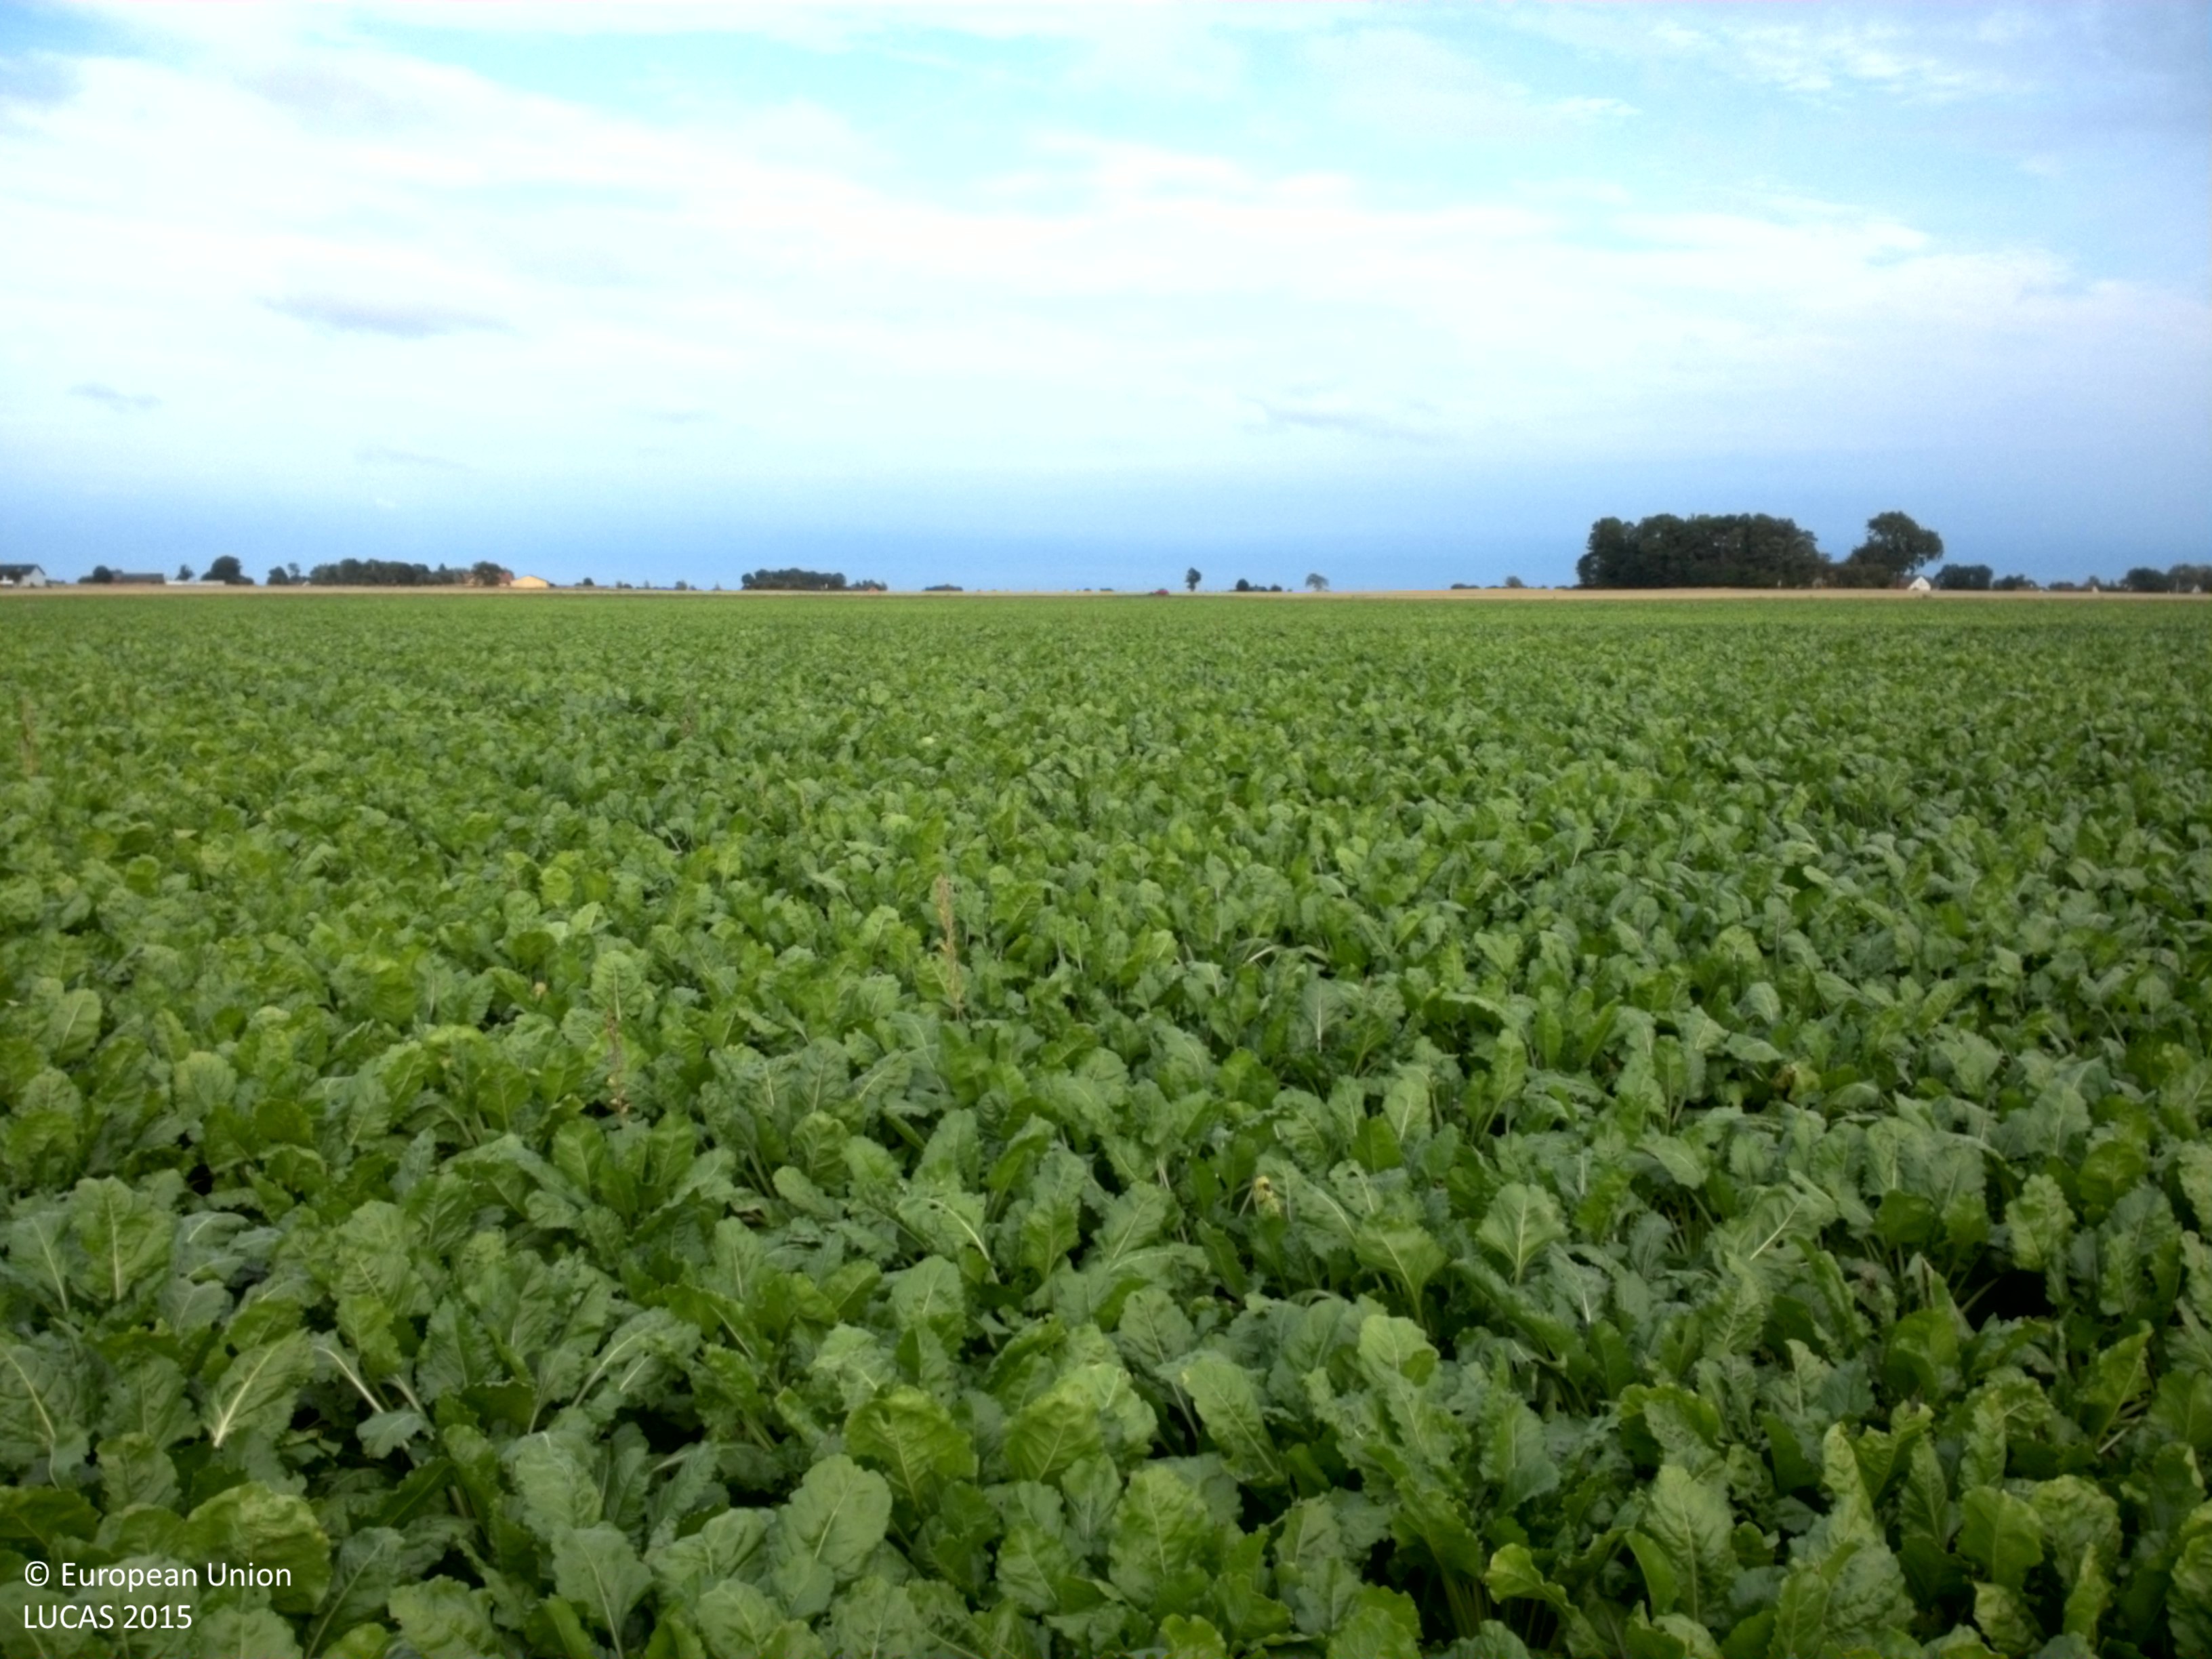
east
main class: Cropland
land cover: Sugar beet
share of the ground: > 75 %
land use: Agriculture (excluding fallow land and kitchen gardens)
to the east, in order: Sugar beet
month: September
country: SE
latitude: 55.4534
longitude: 14.1889
